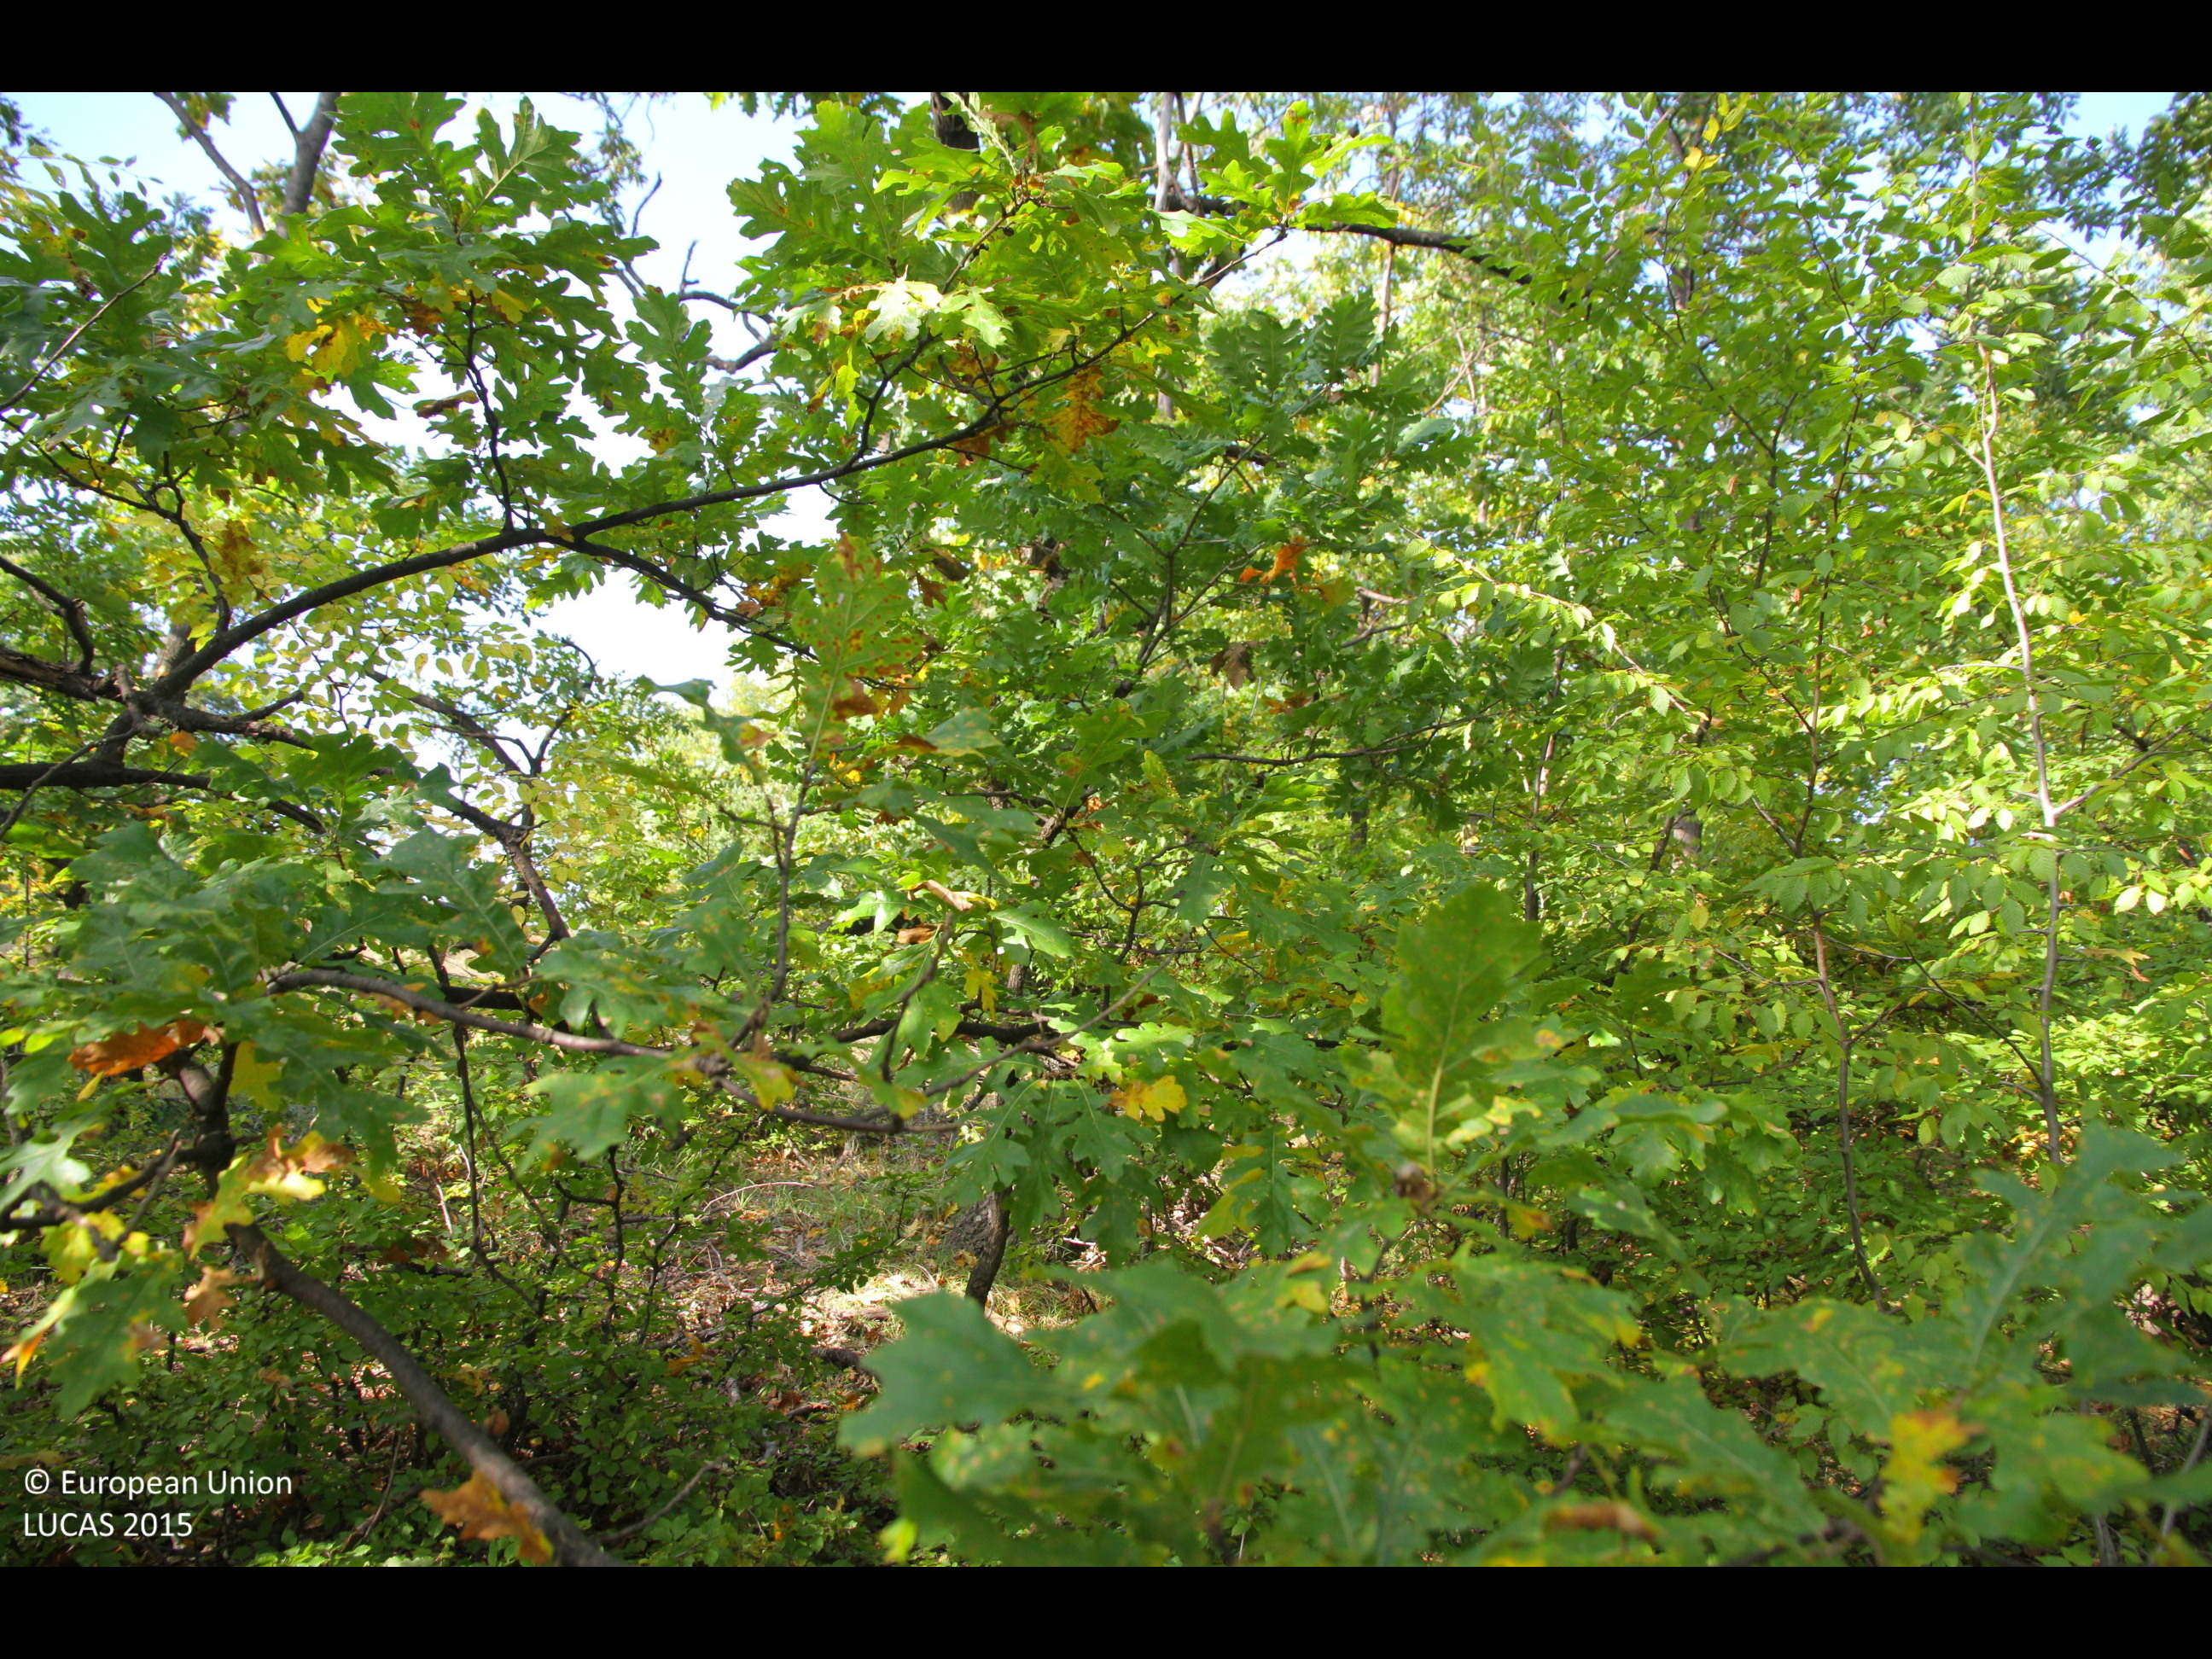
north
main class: Woodland
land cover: Broadleaved woodland
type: thermophilous deciduous forest
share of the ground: > 75 %
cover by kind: broadleaved forest trees 90 %, herbaceous plants 5 %, unconsolidated bare surface 5 %
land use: Forestry
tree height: > 5 m
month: October
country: BG
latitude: 42.9676
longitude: 26.9175
